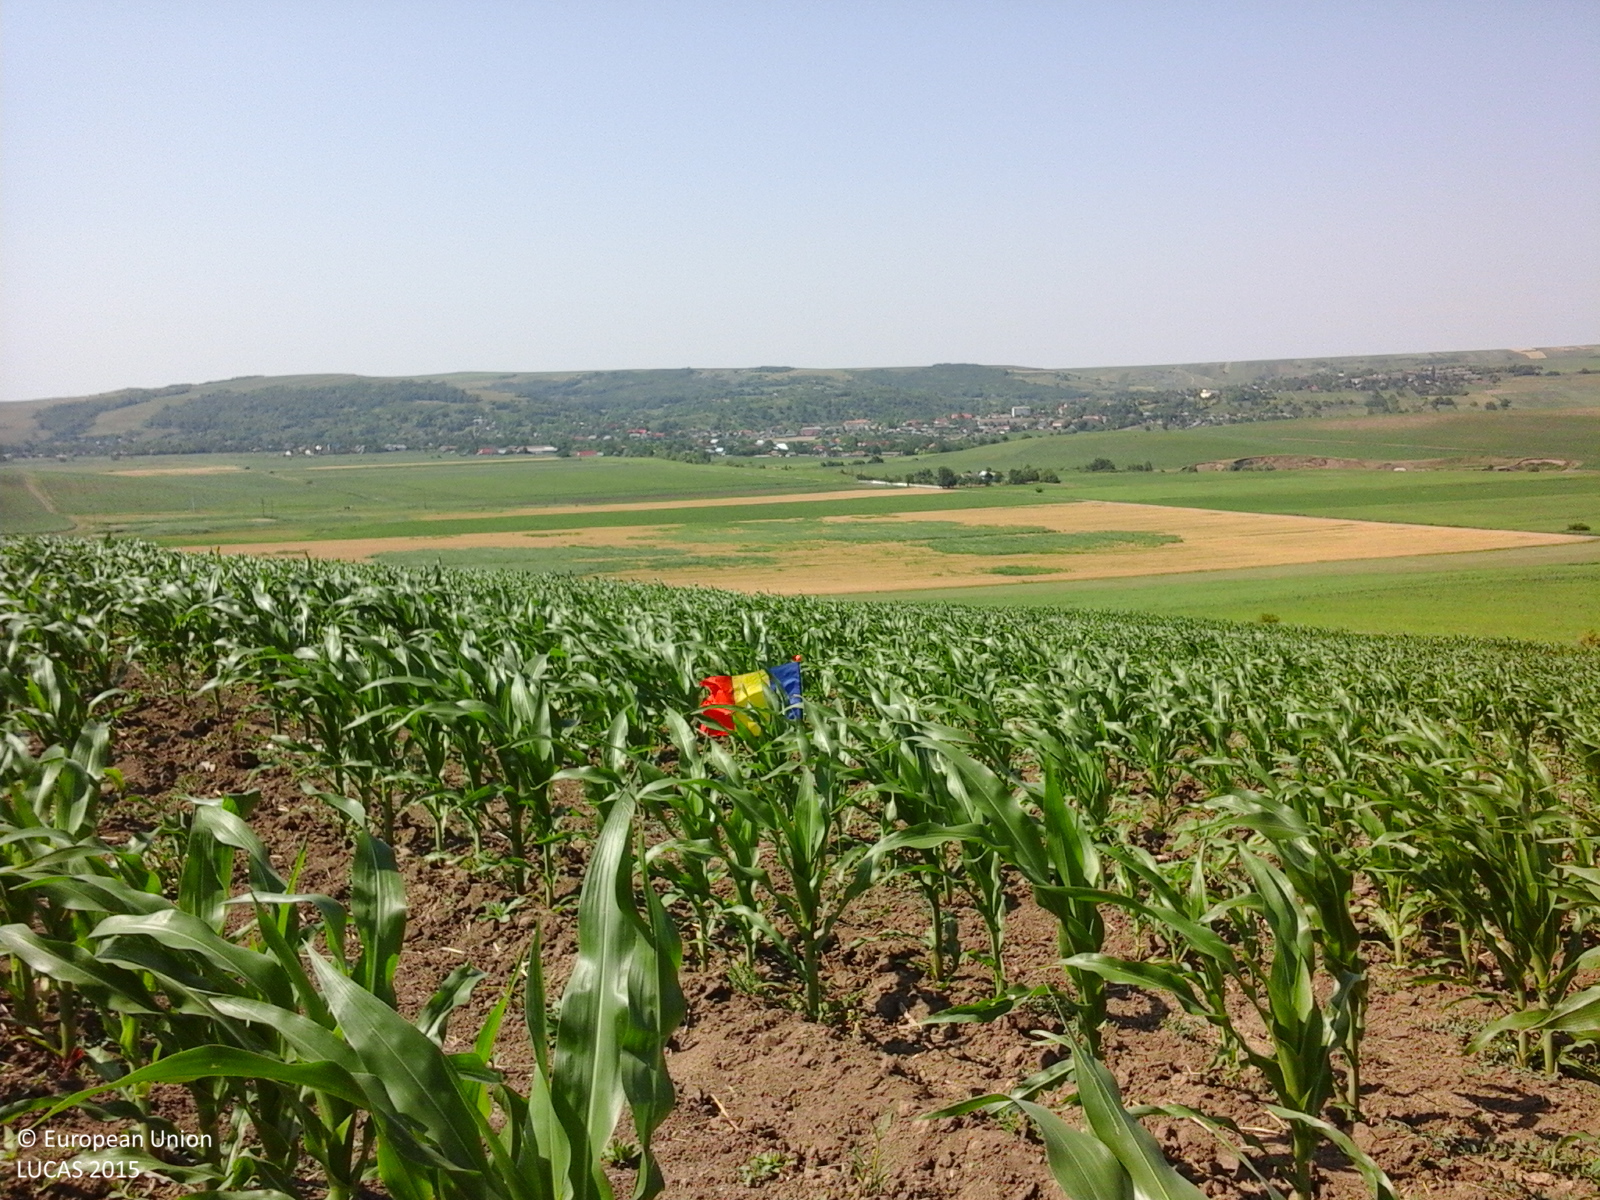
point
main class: Cropland
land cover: Maize
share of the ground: 25 - 50 %
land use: Agriculture (excluding fallow land and kitchen gardens)
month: June
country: RO
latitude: 46.8921
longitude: 27.7752
